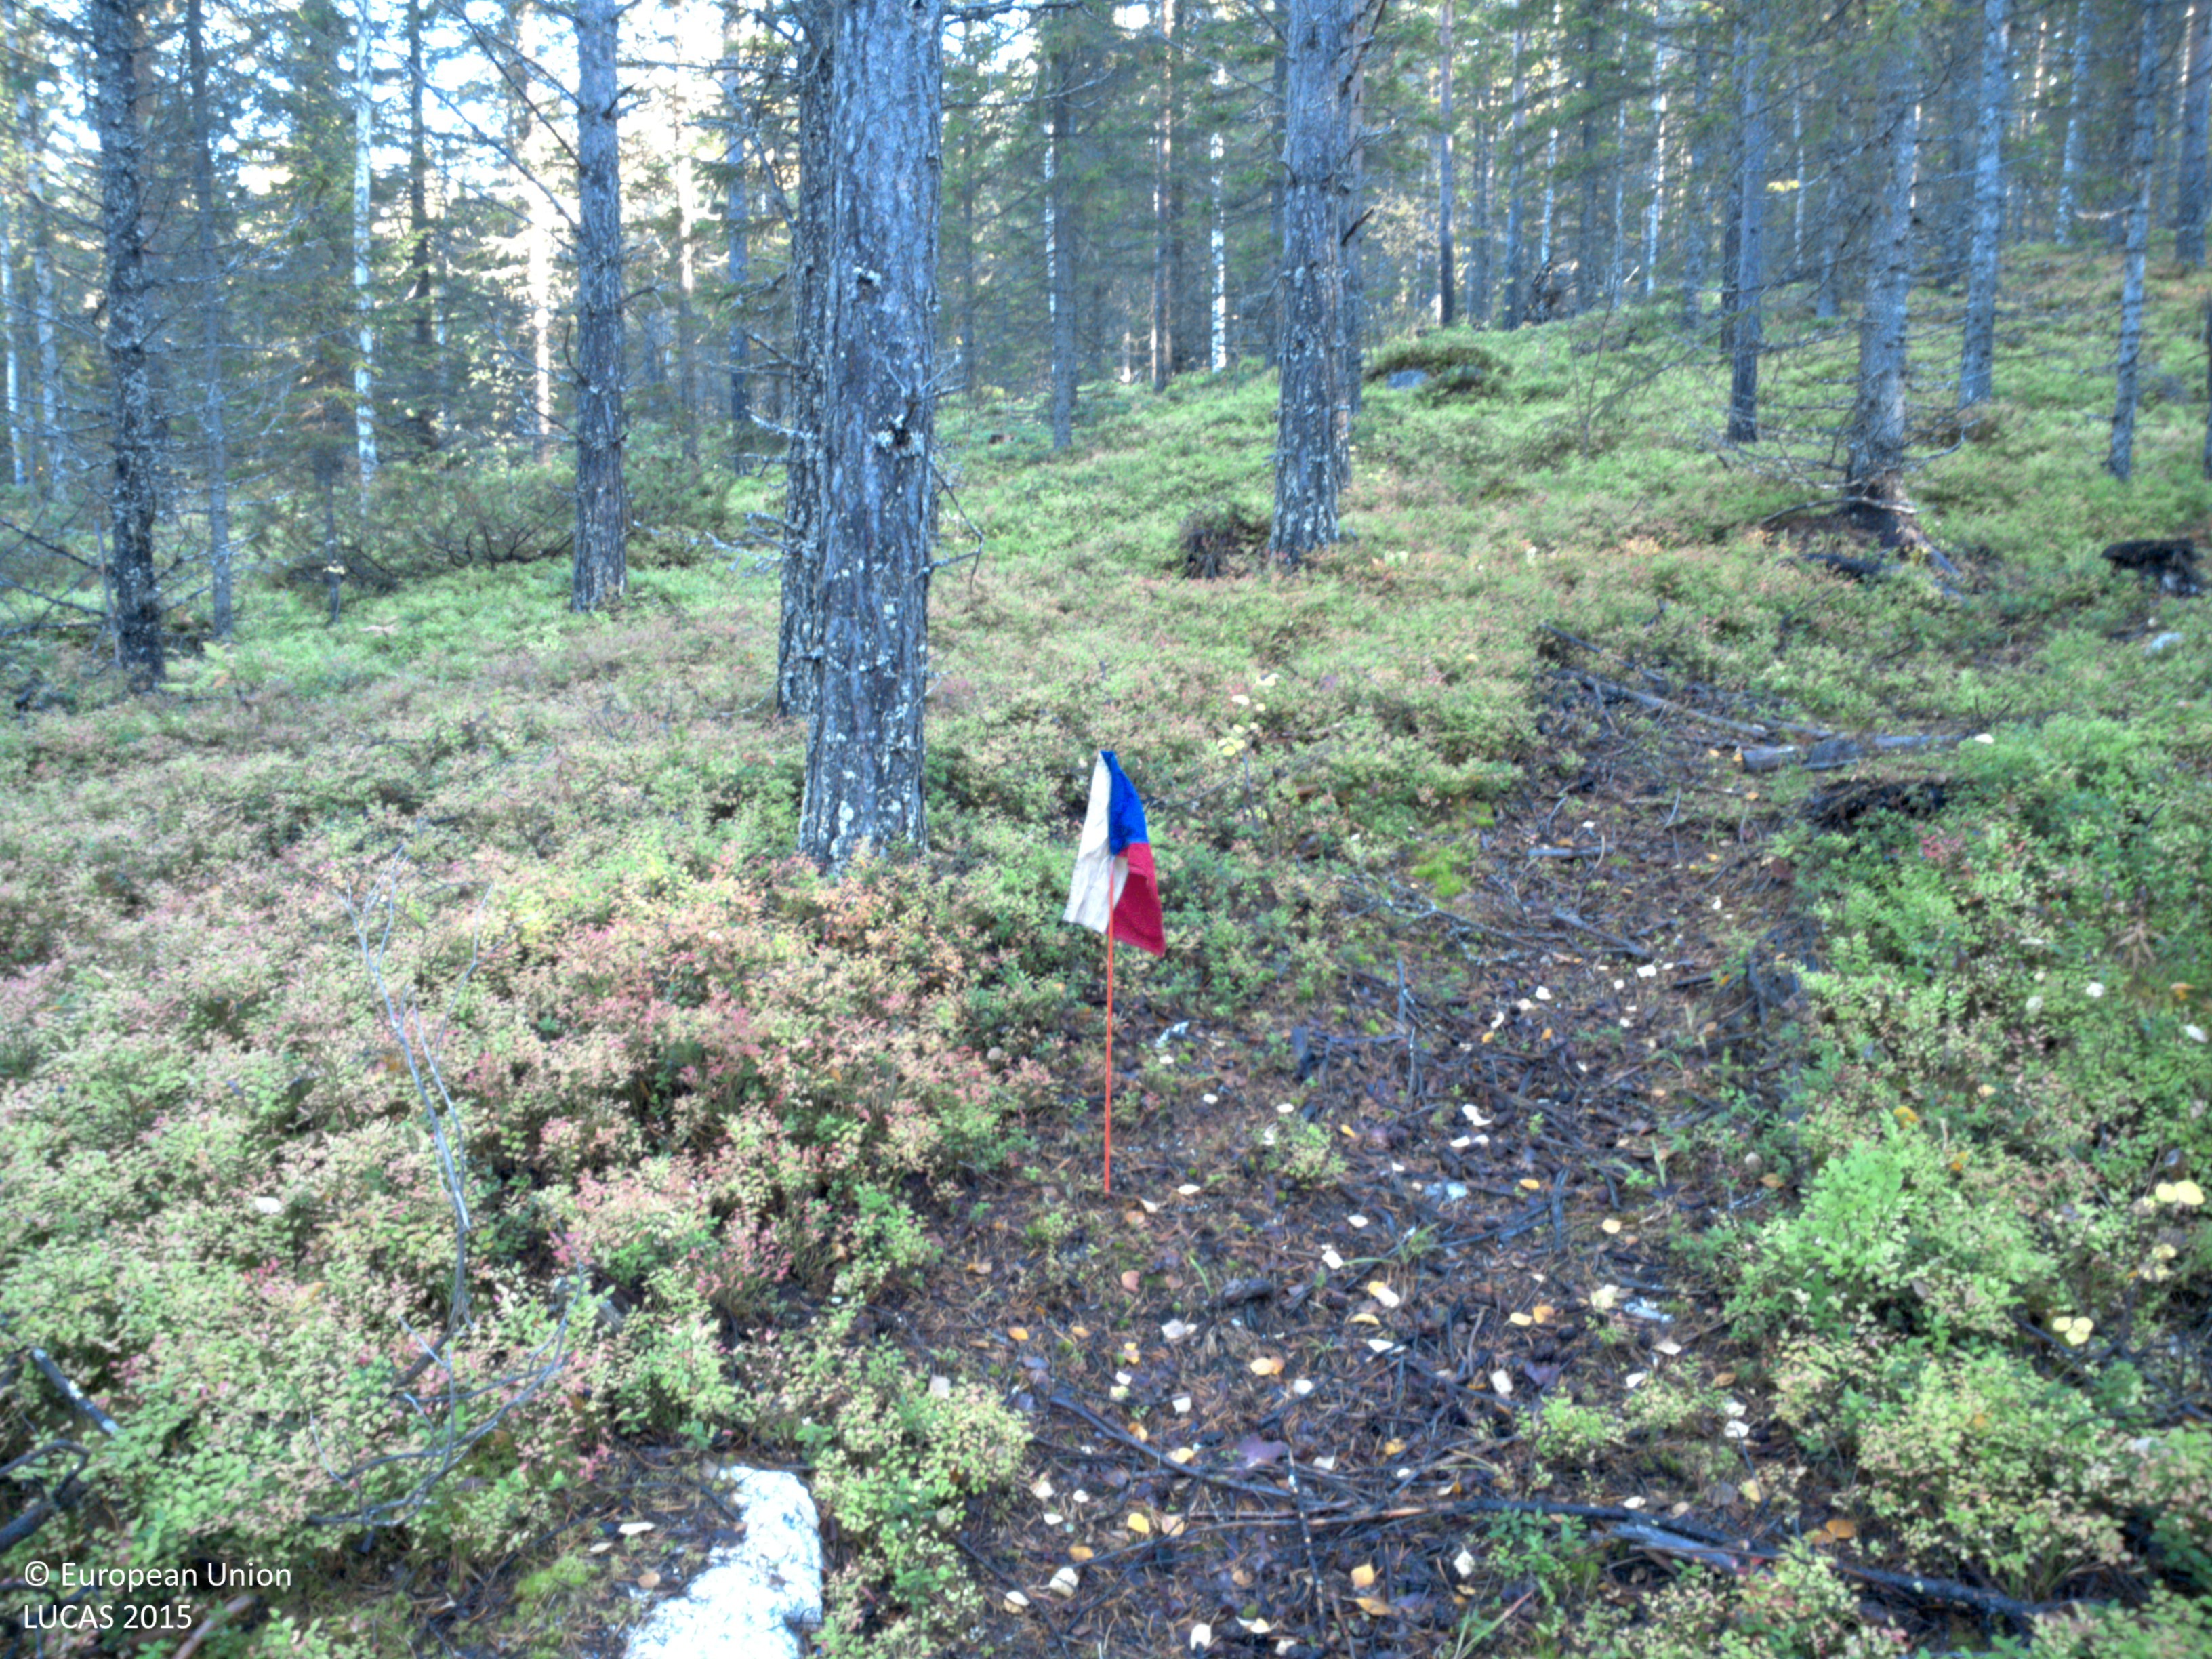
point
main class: Woodland
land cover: Other coniferous woodland
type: boreal forest
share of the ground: > 75 %
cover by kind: coniferous forest trees 75 %, shrubs 15 %, lichens and mosses 10 %
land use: Forestry
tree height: > 5 m
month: September
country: SE
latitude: 64.8358
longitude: 18.9668
